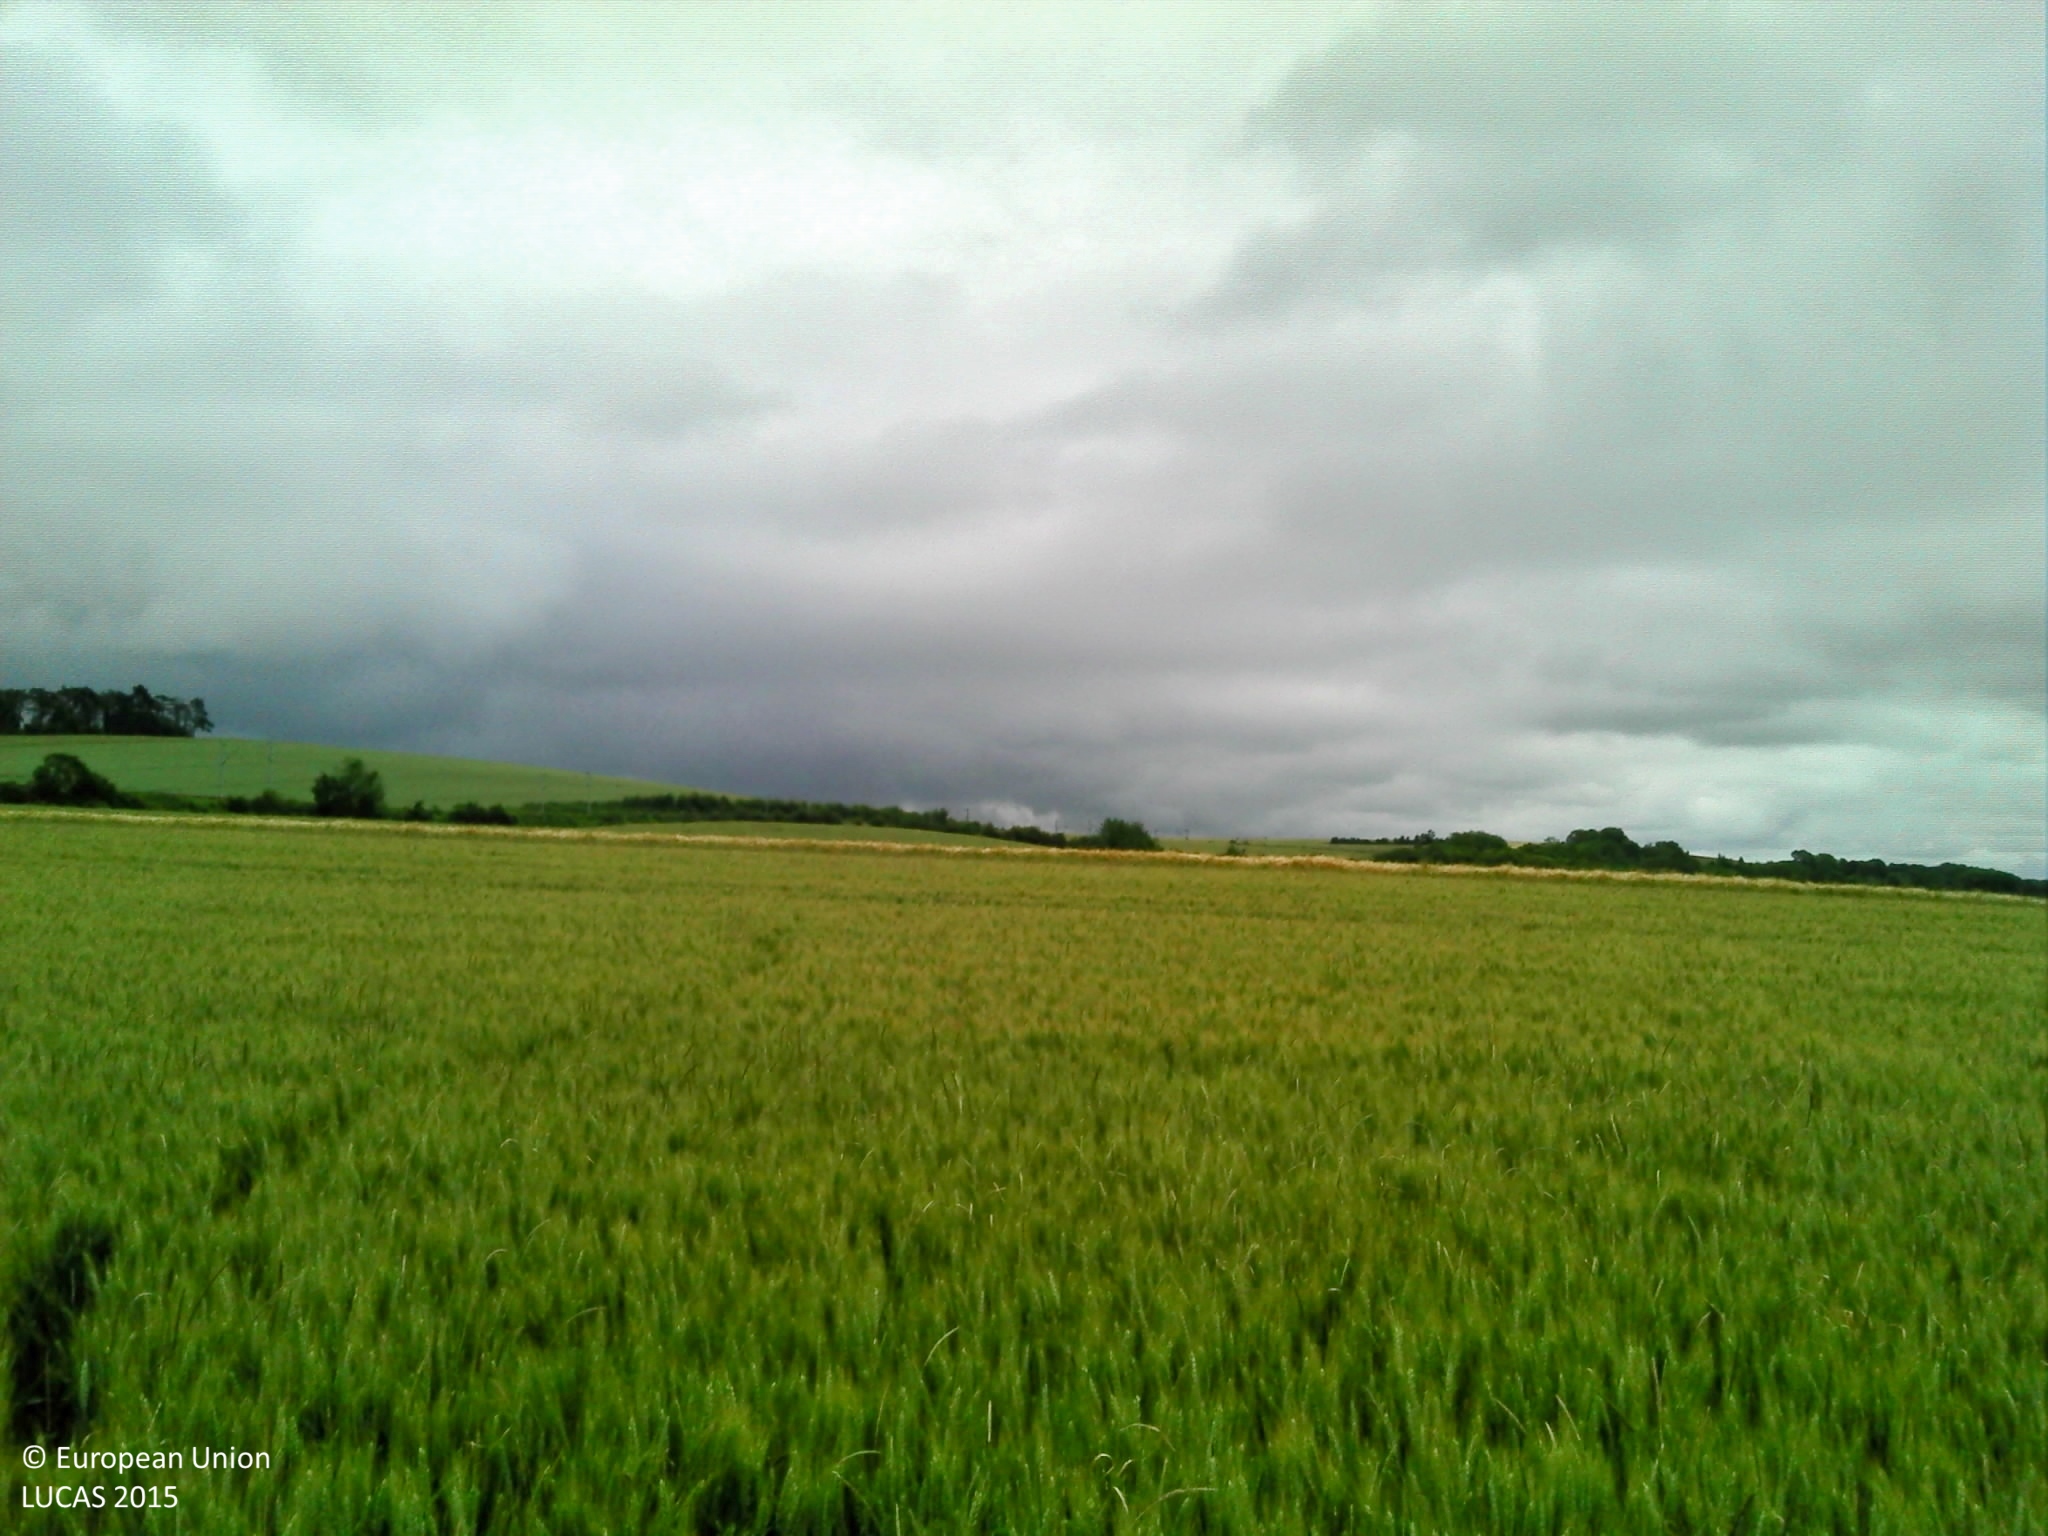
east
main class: Cropland
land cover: Common wheat
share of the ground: > 75 %
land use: Agriculture (excluding fallow land and kitchen gardens)
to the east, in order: Common wheat; Grass margins; Triticale; Grass margins; Rape and turnip rape; Grass margins
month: June
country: FR
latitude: 49.6046
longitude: 2.3904
